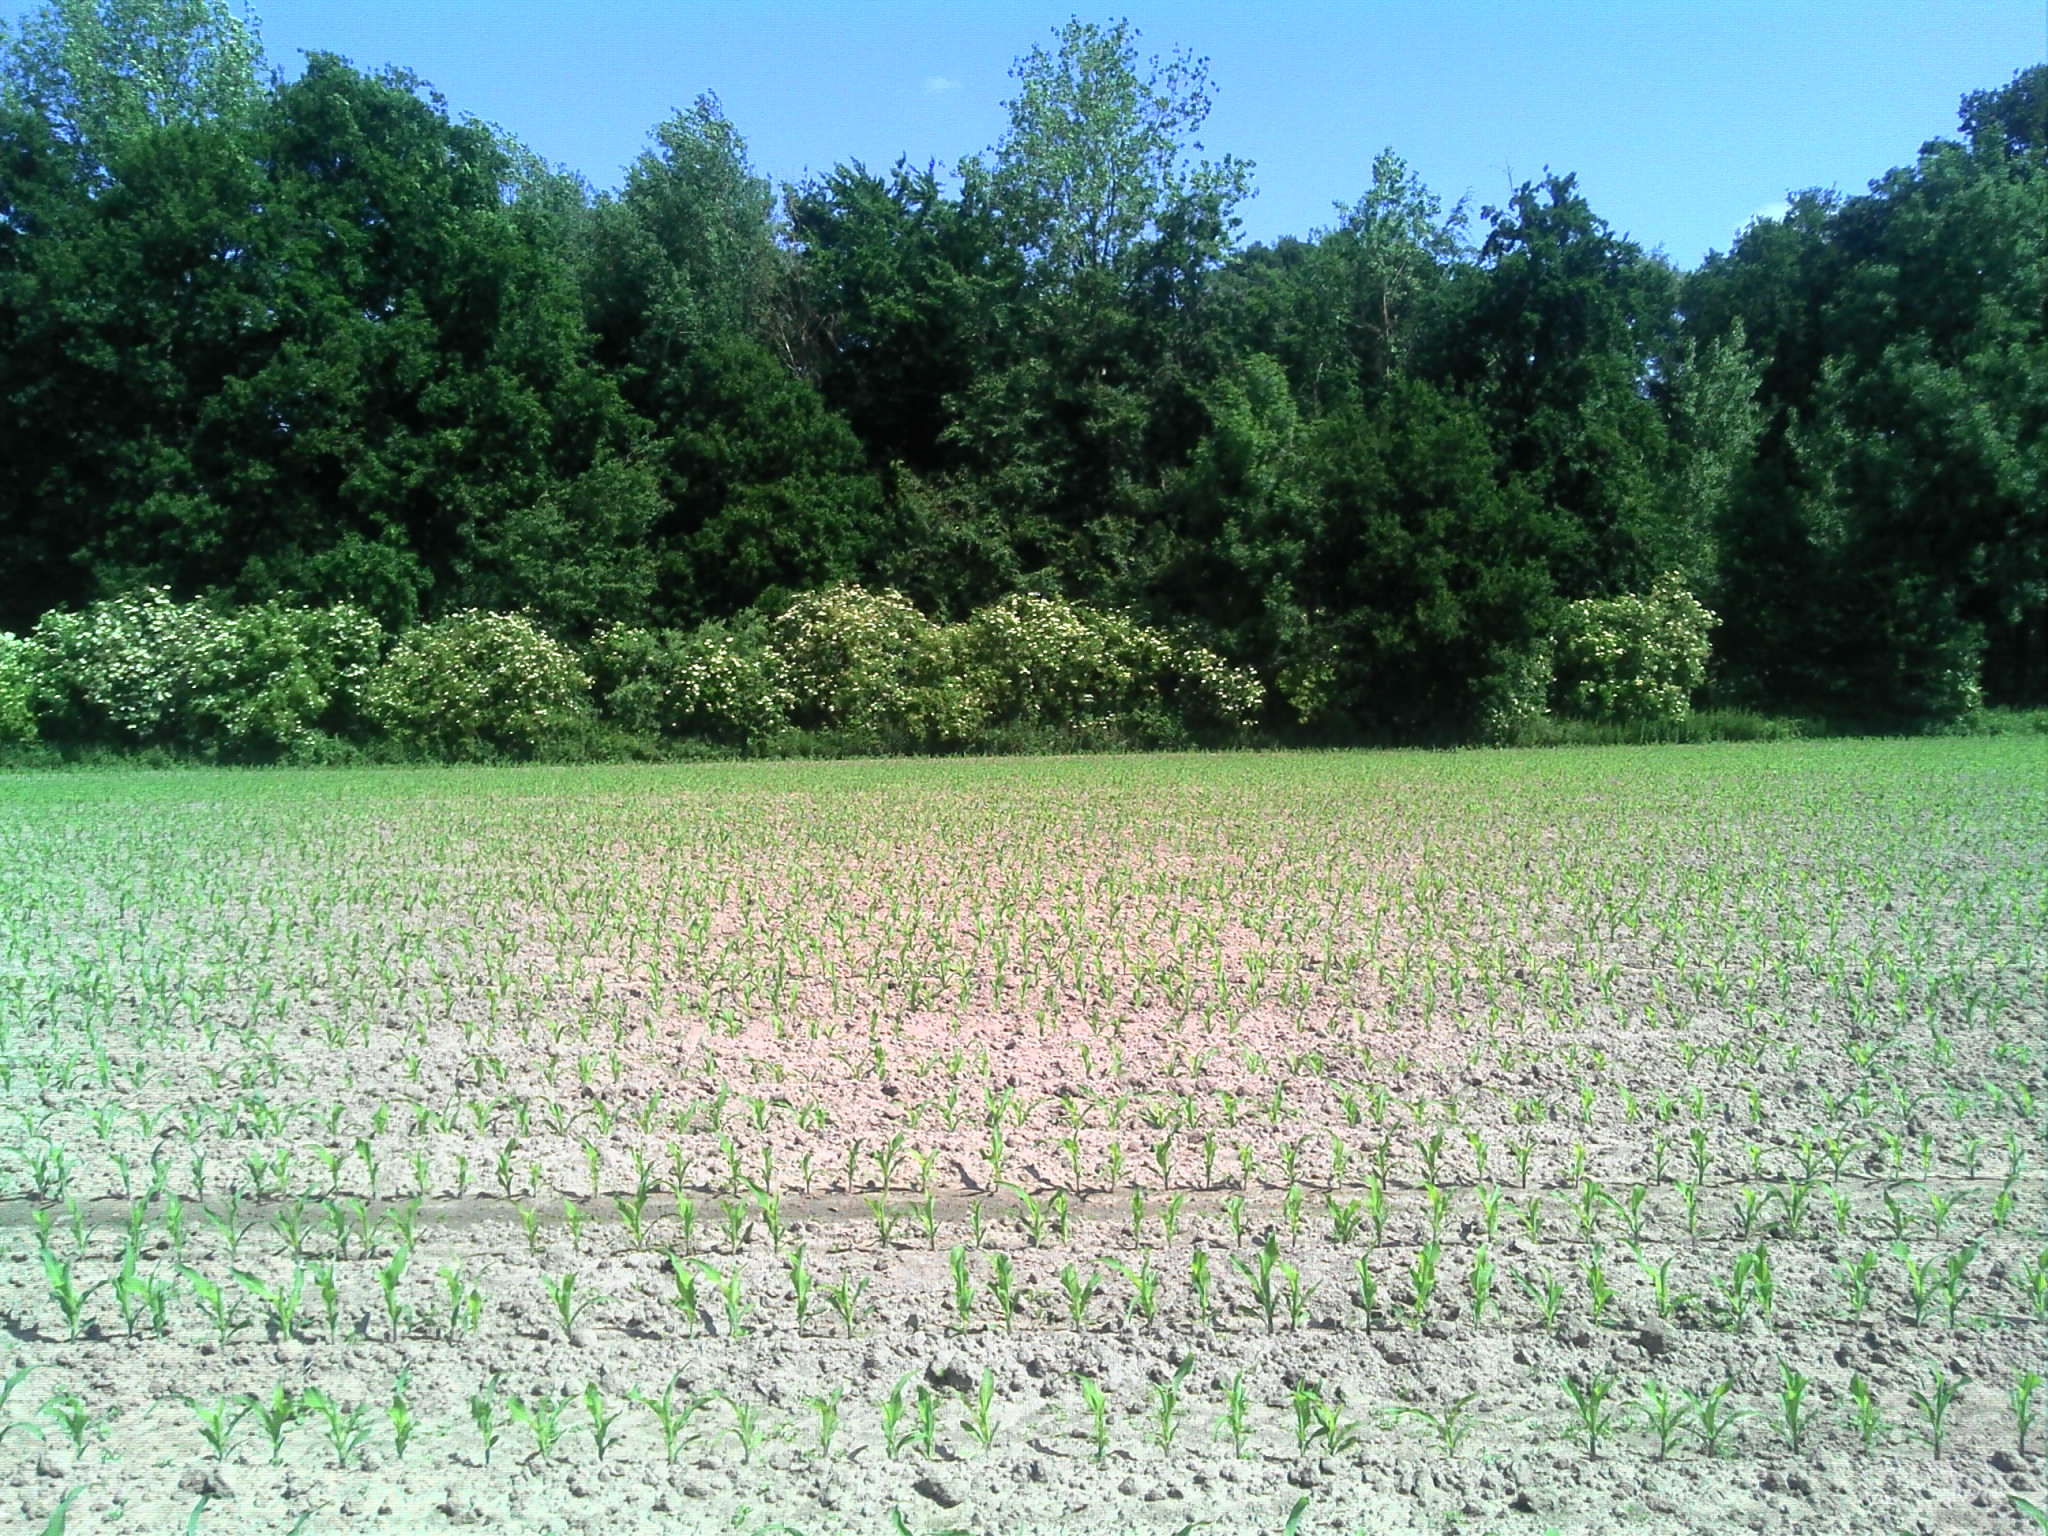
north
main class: Cropland
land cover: Maize
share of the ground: 10 - 25 %
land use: Agriculture (excluding fallow land and kitchen gardens)
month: June
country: BE
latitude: 51.0140
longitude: 4.2792
